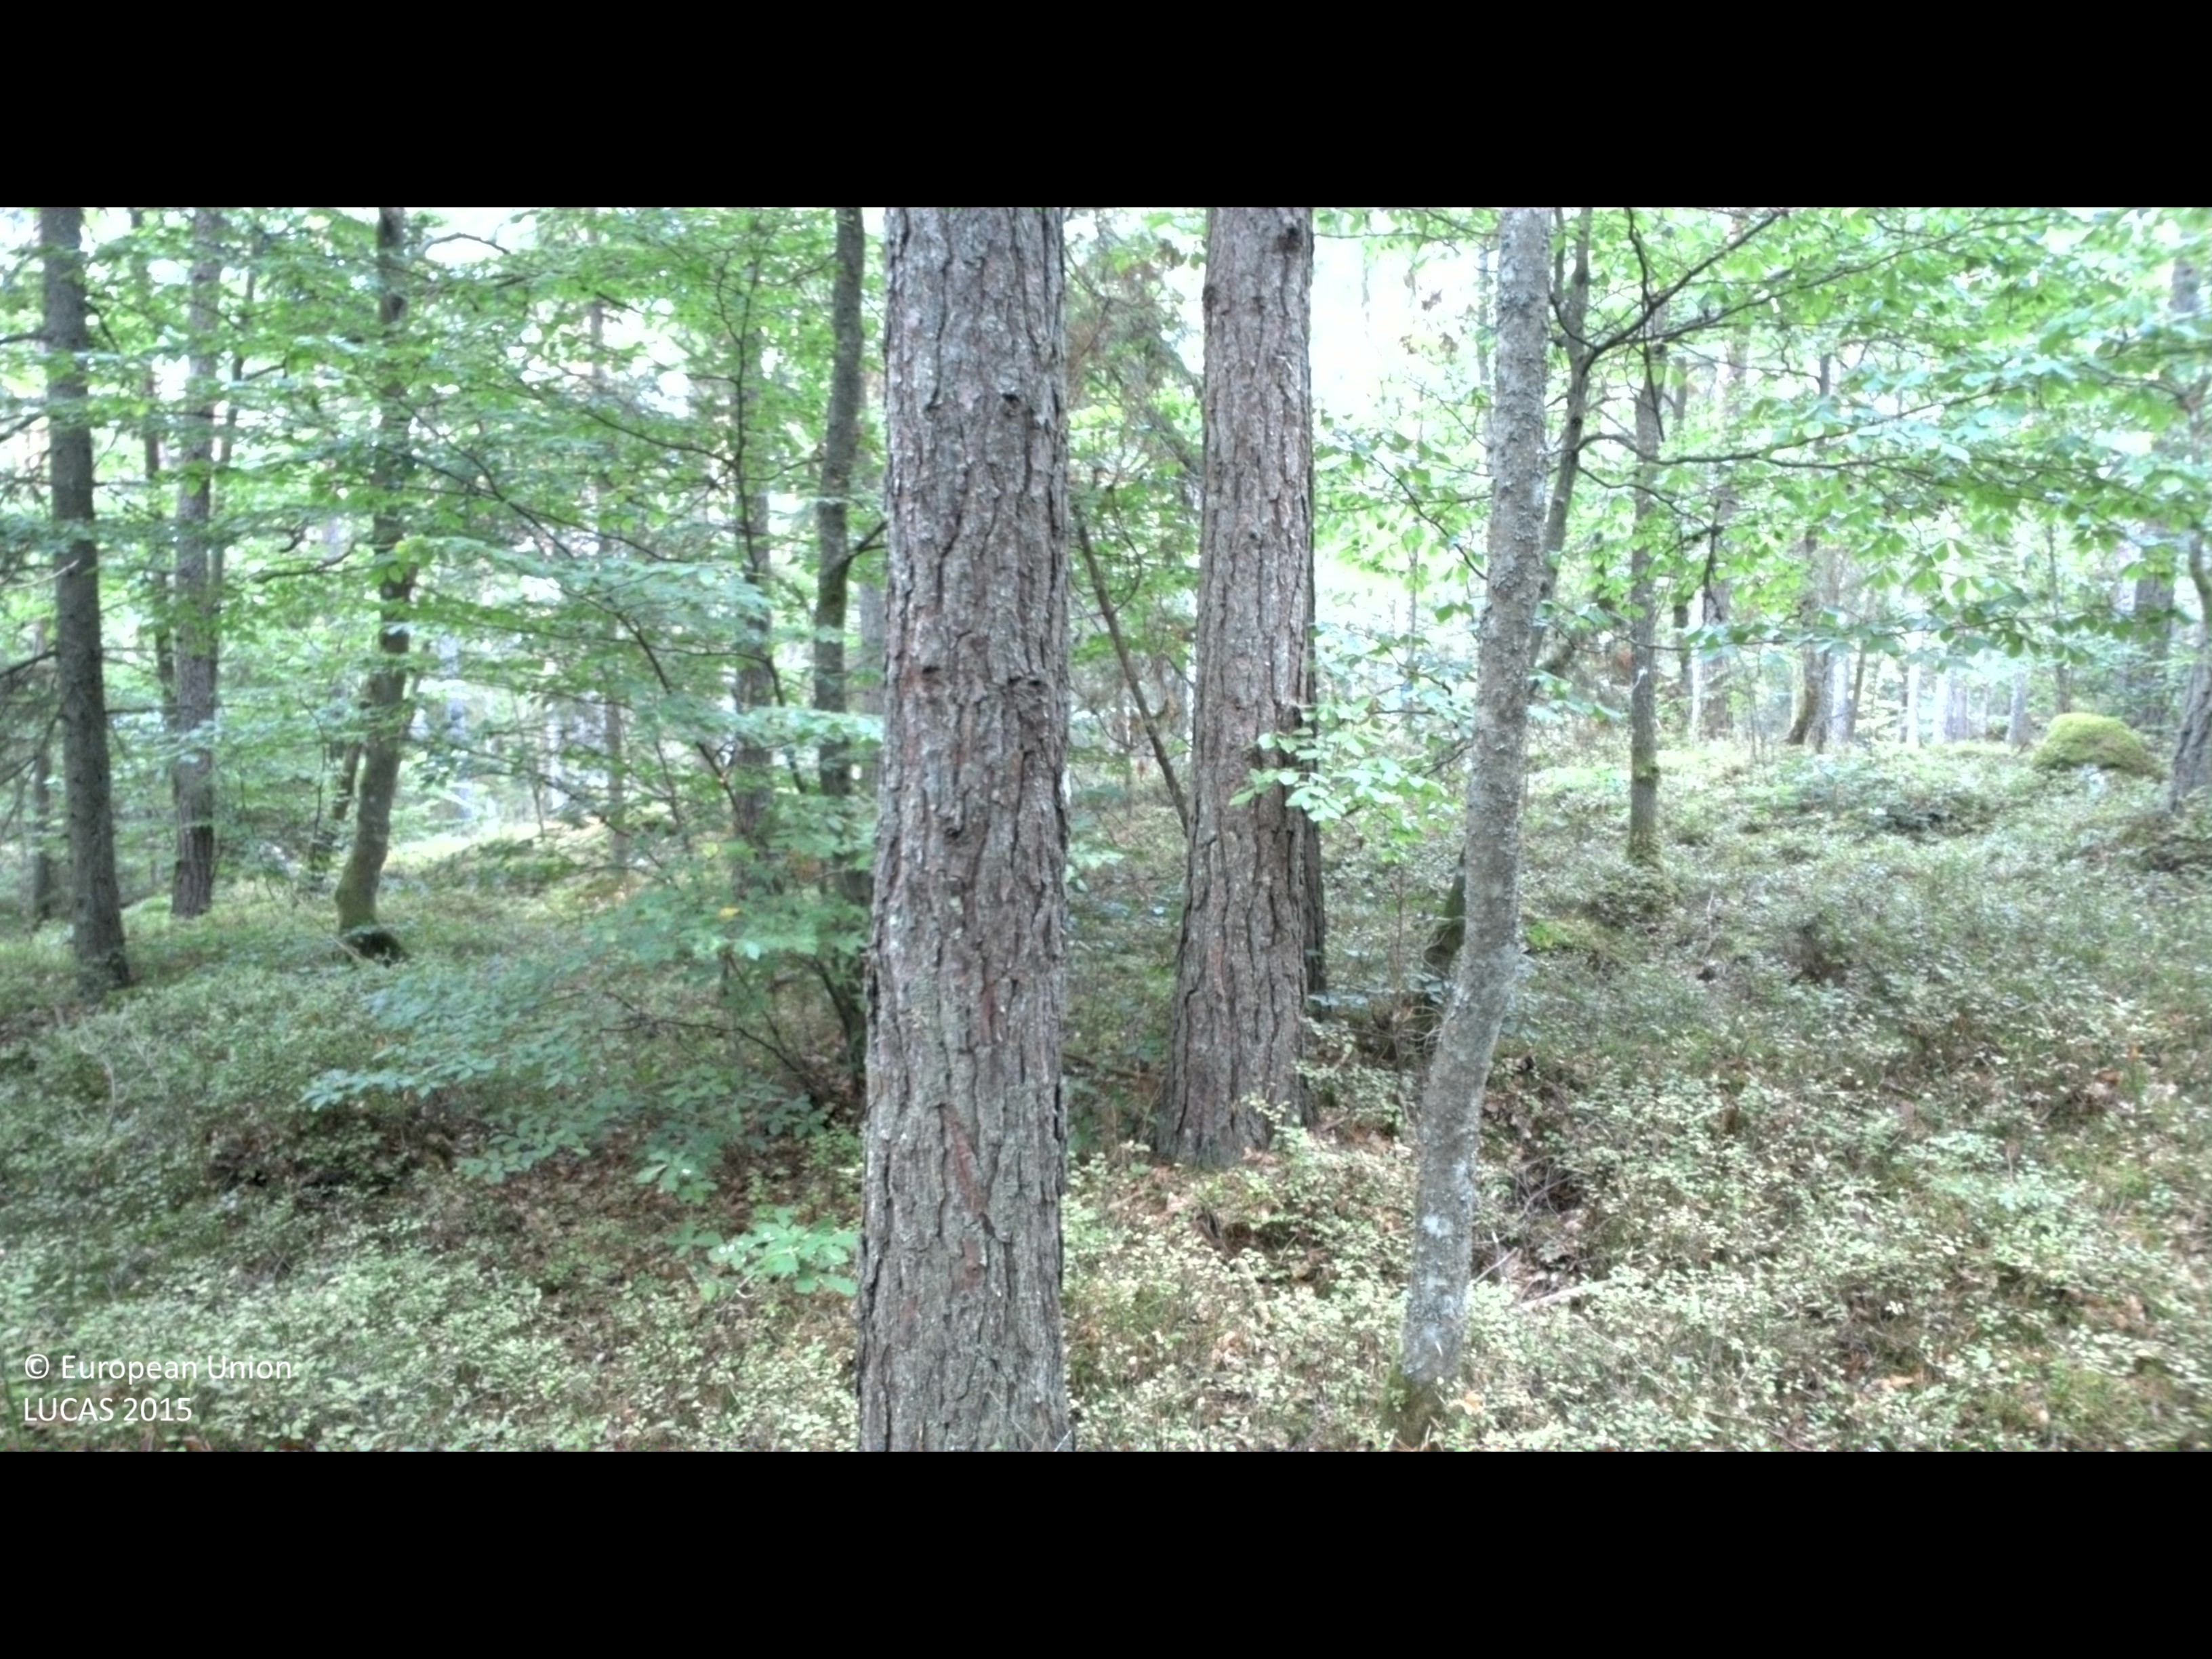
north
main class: Woodland
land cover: Pine dominated mixed woodland
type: hemiboreal forest and nemoral coniferous forest and mixed broadleaved-coniferous forest
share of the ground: 50 - 75 %
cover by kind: coniferous forest trees 50 %, broadleaved forest trees 20 %, shrubs 20 %, lichens and mosses 10 %
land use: Forestry
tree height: > 5 m
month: September
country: SE
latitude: 56.2877
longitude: 15.0228
